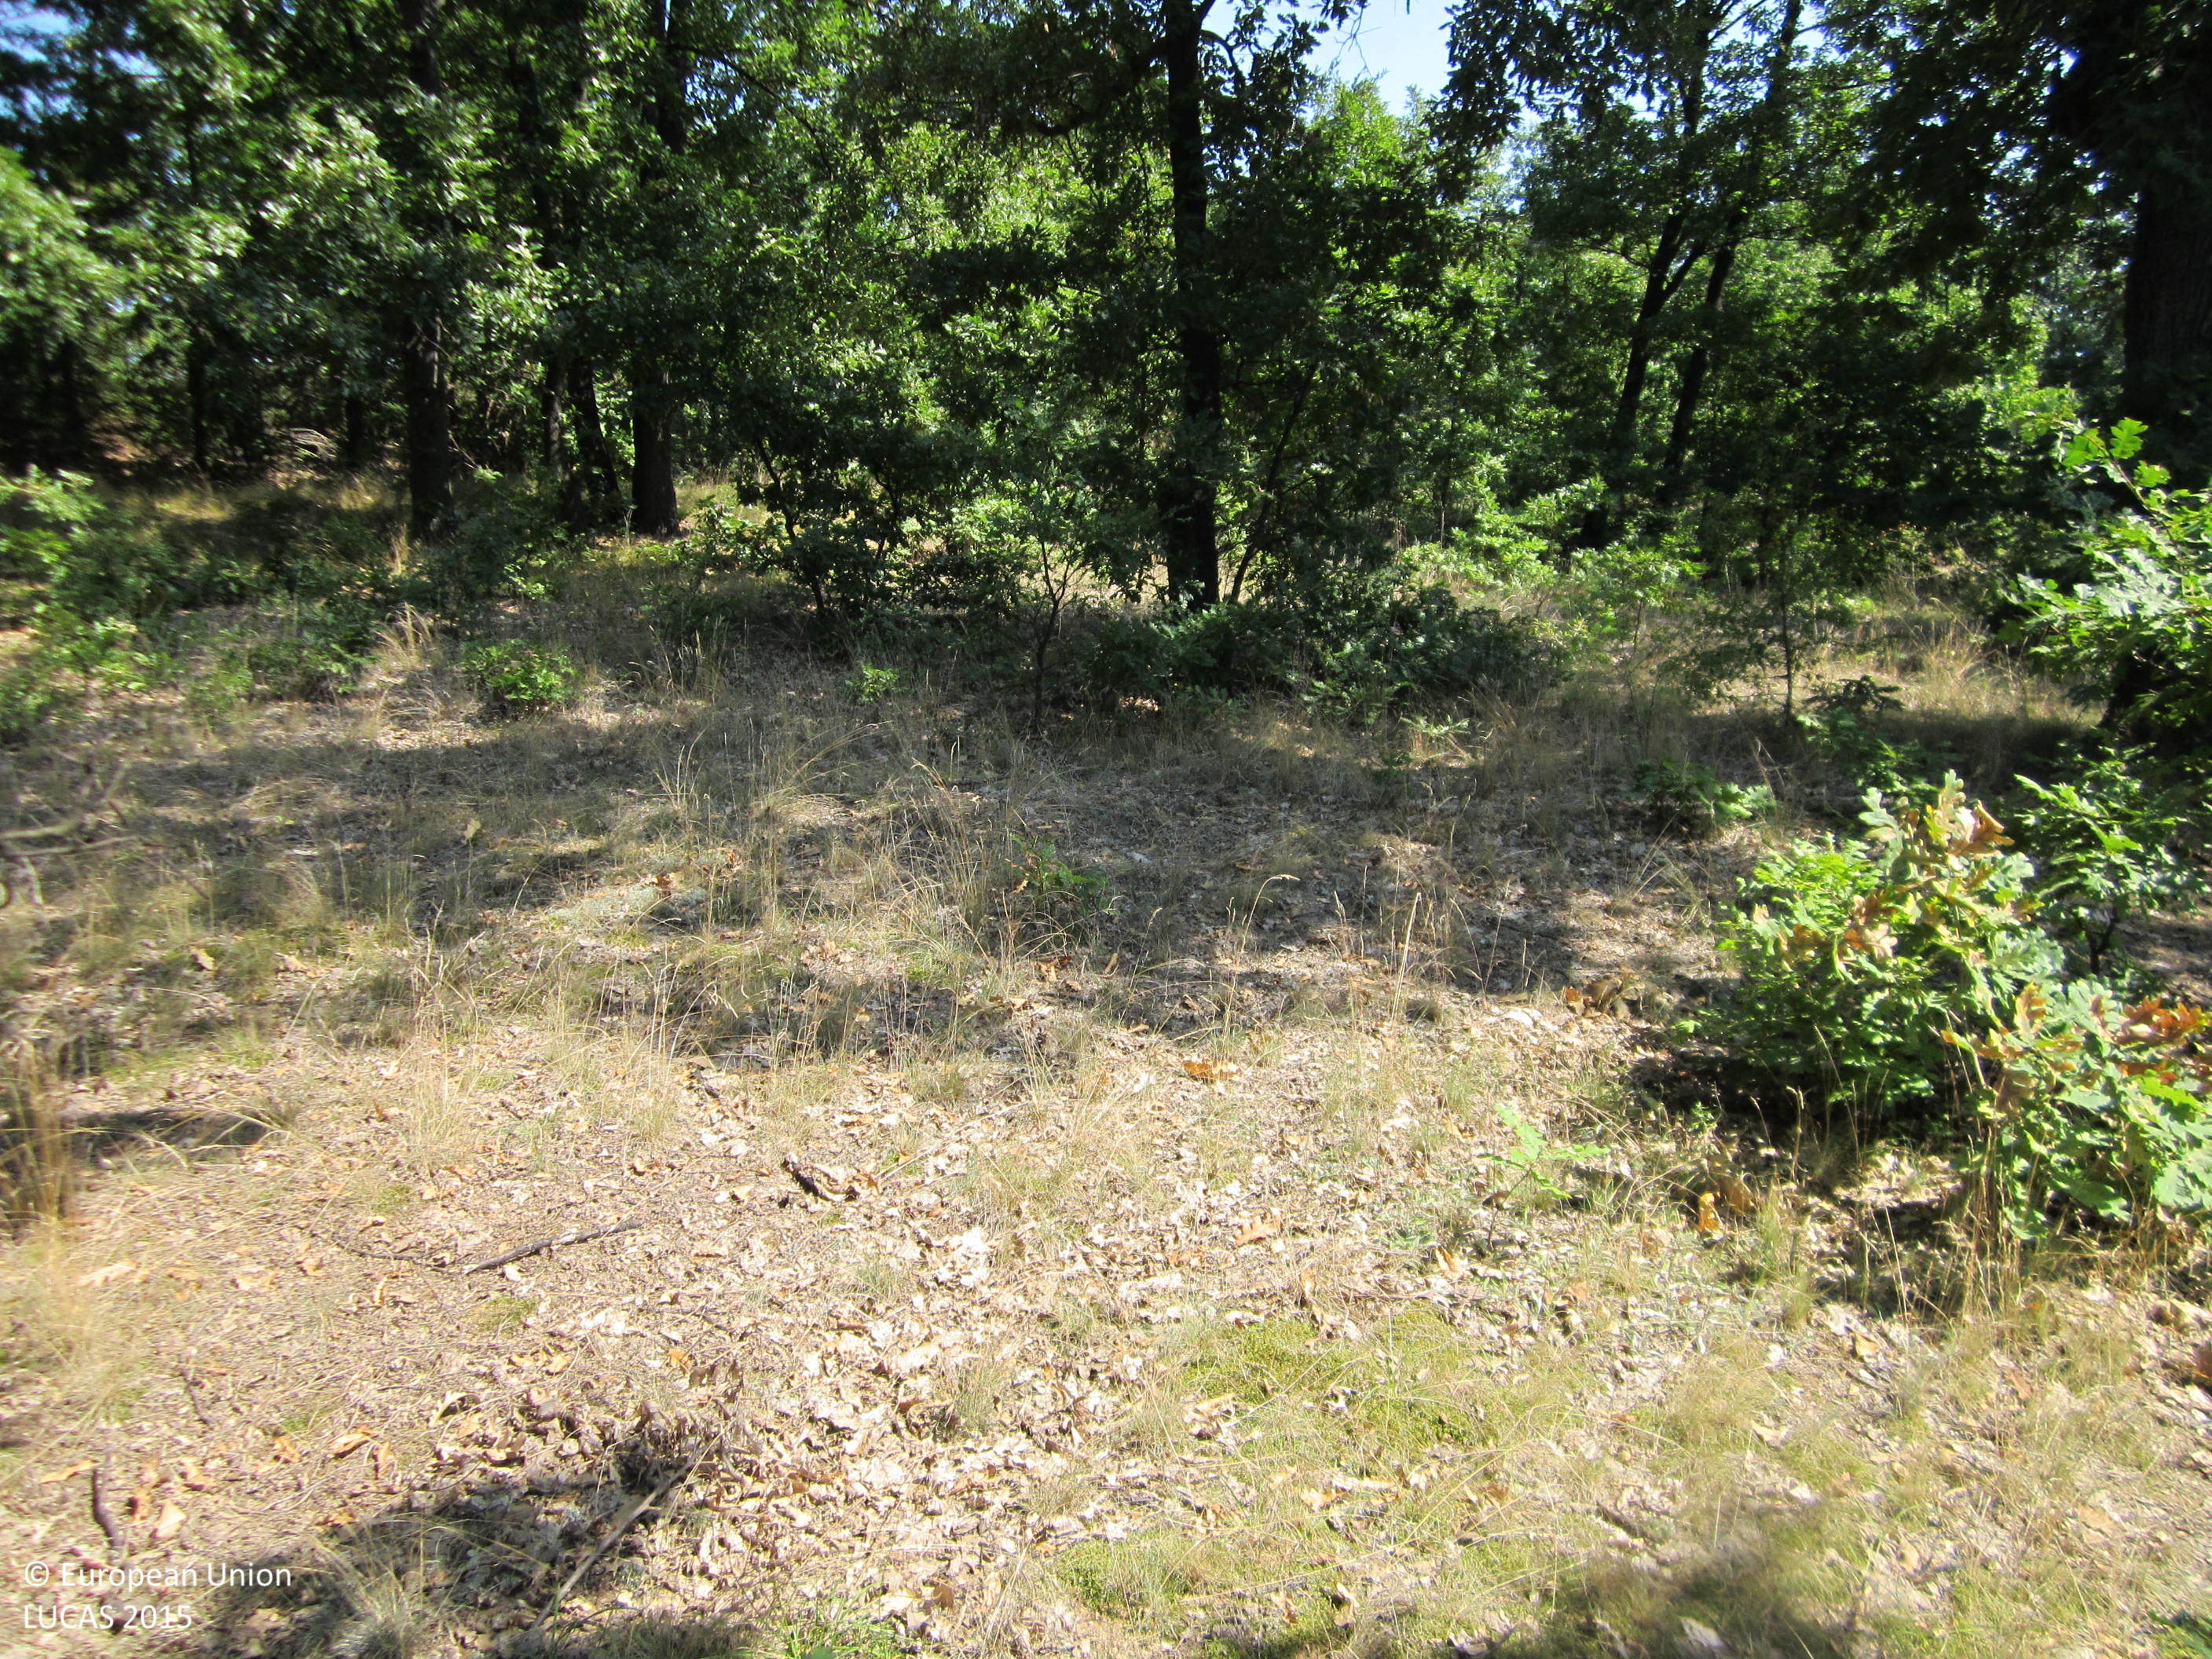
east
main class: Woodland
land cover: Broadleaved woodland
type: thermophilous deciduous forest
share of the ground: > 75 %
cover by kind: broadleaved forest trees 75 %, herbaceous plants 20 %, unconsolidated bare surface 5 %
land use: Forestry
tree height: > 5 m
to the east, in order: Broadleaved woodland; Tracks; Broadleaved woodland; Tracks; Broadleaved woodland
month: September
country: BG
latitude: 42.8556
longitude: 27.0355
